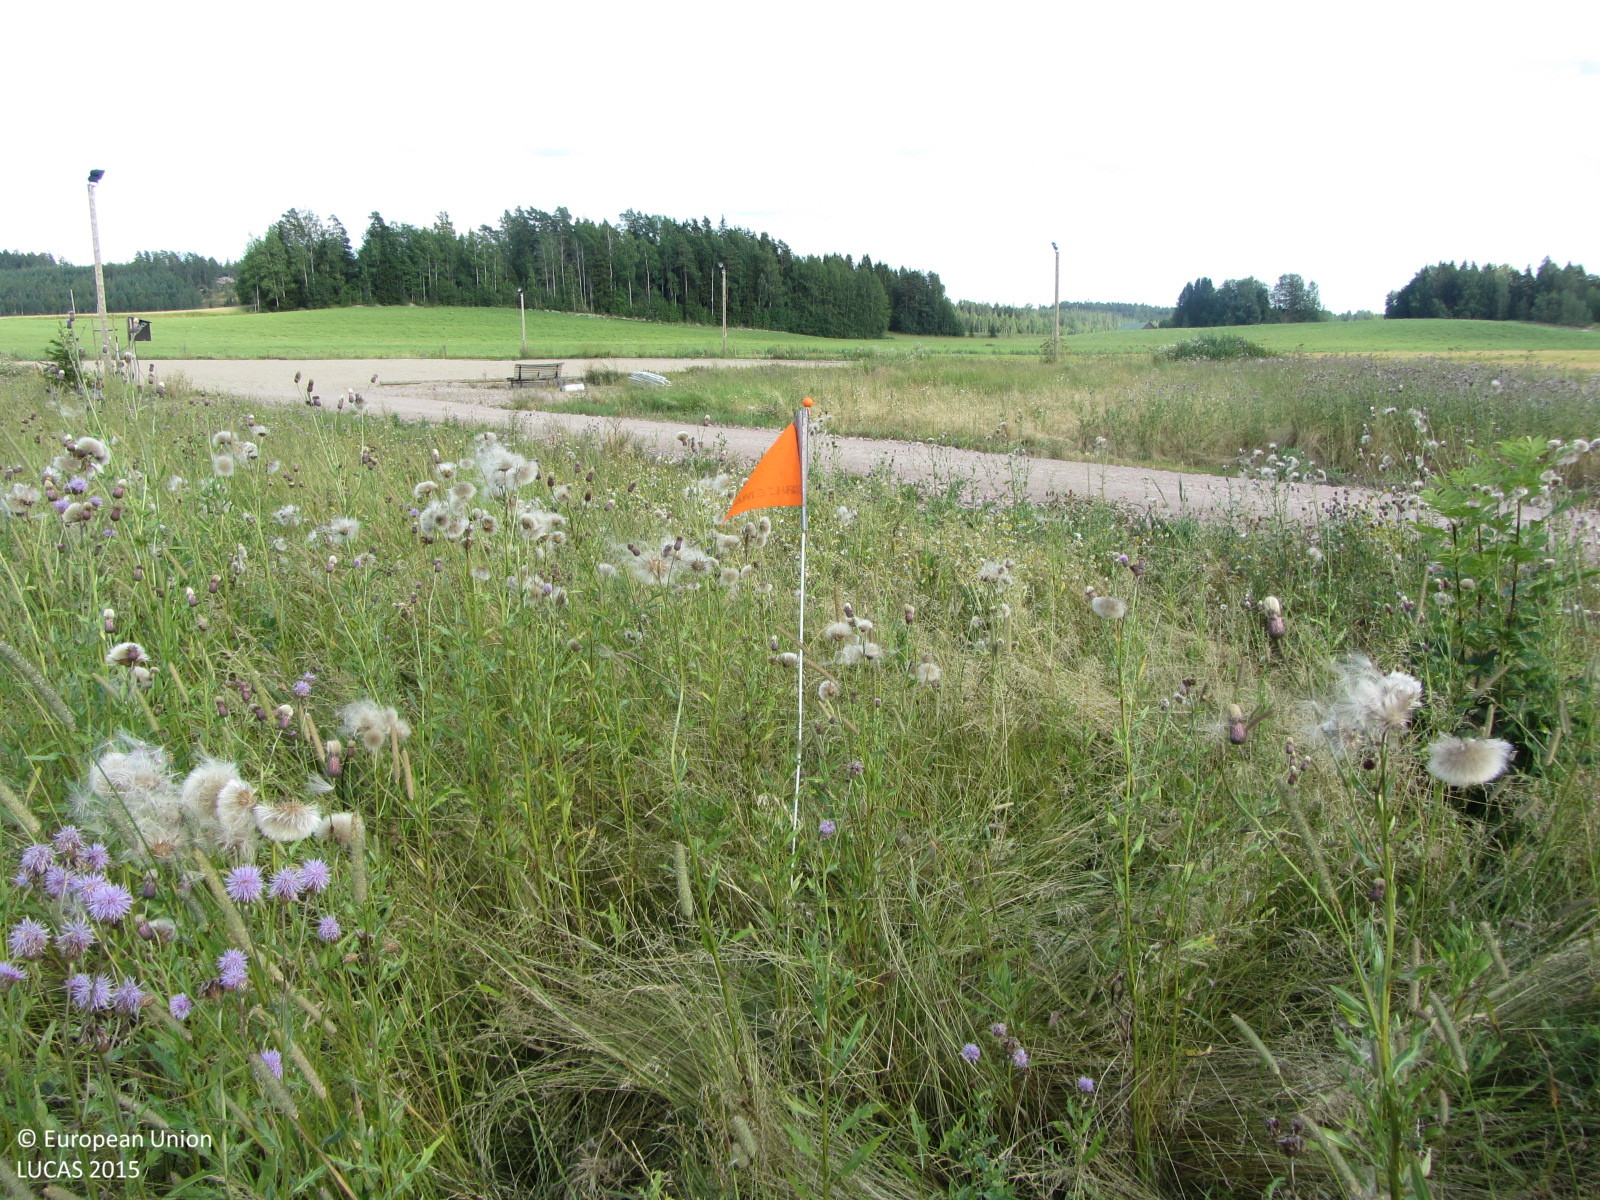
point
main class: Grassland
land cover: Spontaneously vegetated surfaces
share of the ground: > 75 %
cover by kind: herbaceous plants 100 %
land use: Fallow land
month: August
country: FI
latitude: 60.3708
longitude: 23.4880
